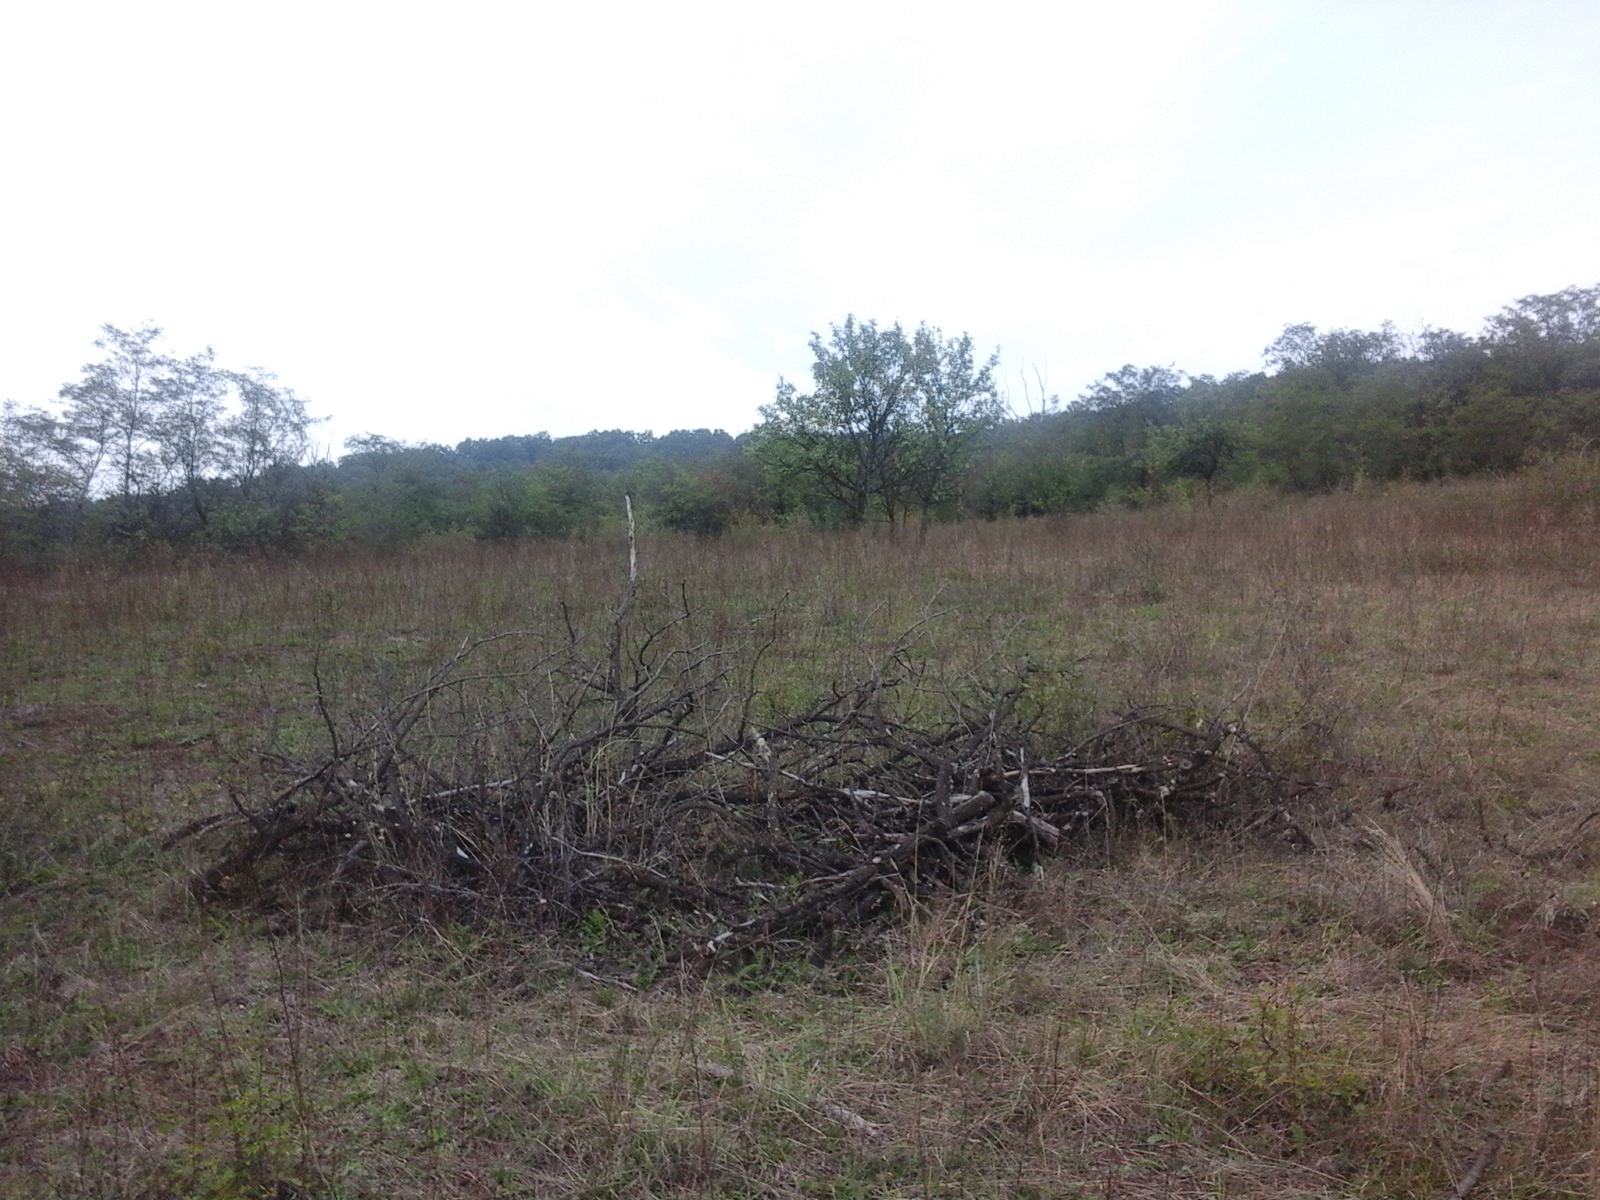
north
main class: Cropland
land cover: Other fruit trees and berries
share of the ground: > 75 %
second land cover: Grassland without tree/shrub cover
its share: > 75 %
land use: Agriculture (excluding fallow land and kitchen gardens)
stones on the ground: < 10 %
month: September
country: RO
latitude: 45.7576
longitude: 22.9749
